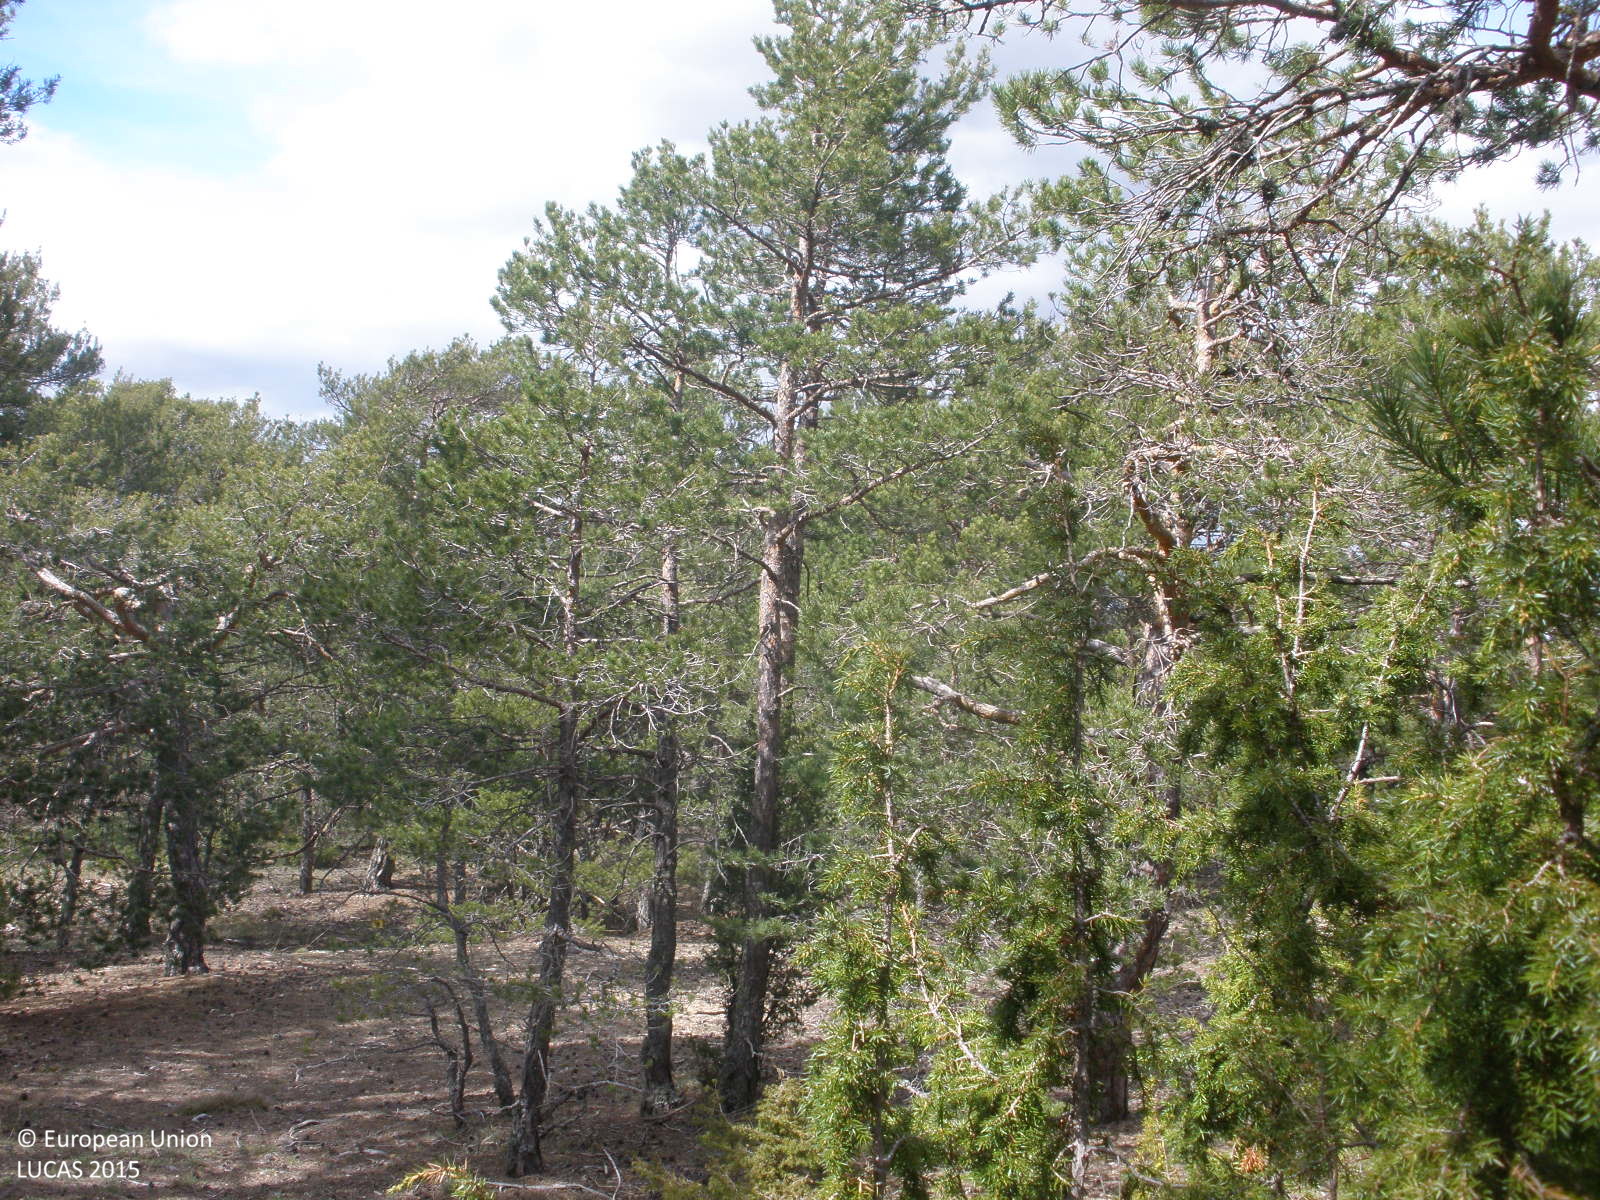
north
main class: Woodland
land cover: Pine dominated coniferous woodland
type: coniferous forest of the mediterranean region
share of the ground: 50 - 75 %
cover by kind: coniferous forest trees 70 %, herbaceous plants 20 %, shrubs 10 %
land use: Forestry
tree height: > 5 m
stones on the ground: < 10 %
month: April
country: ES
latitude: 40.3999
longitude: -0.7899
